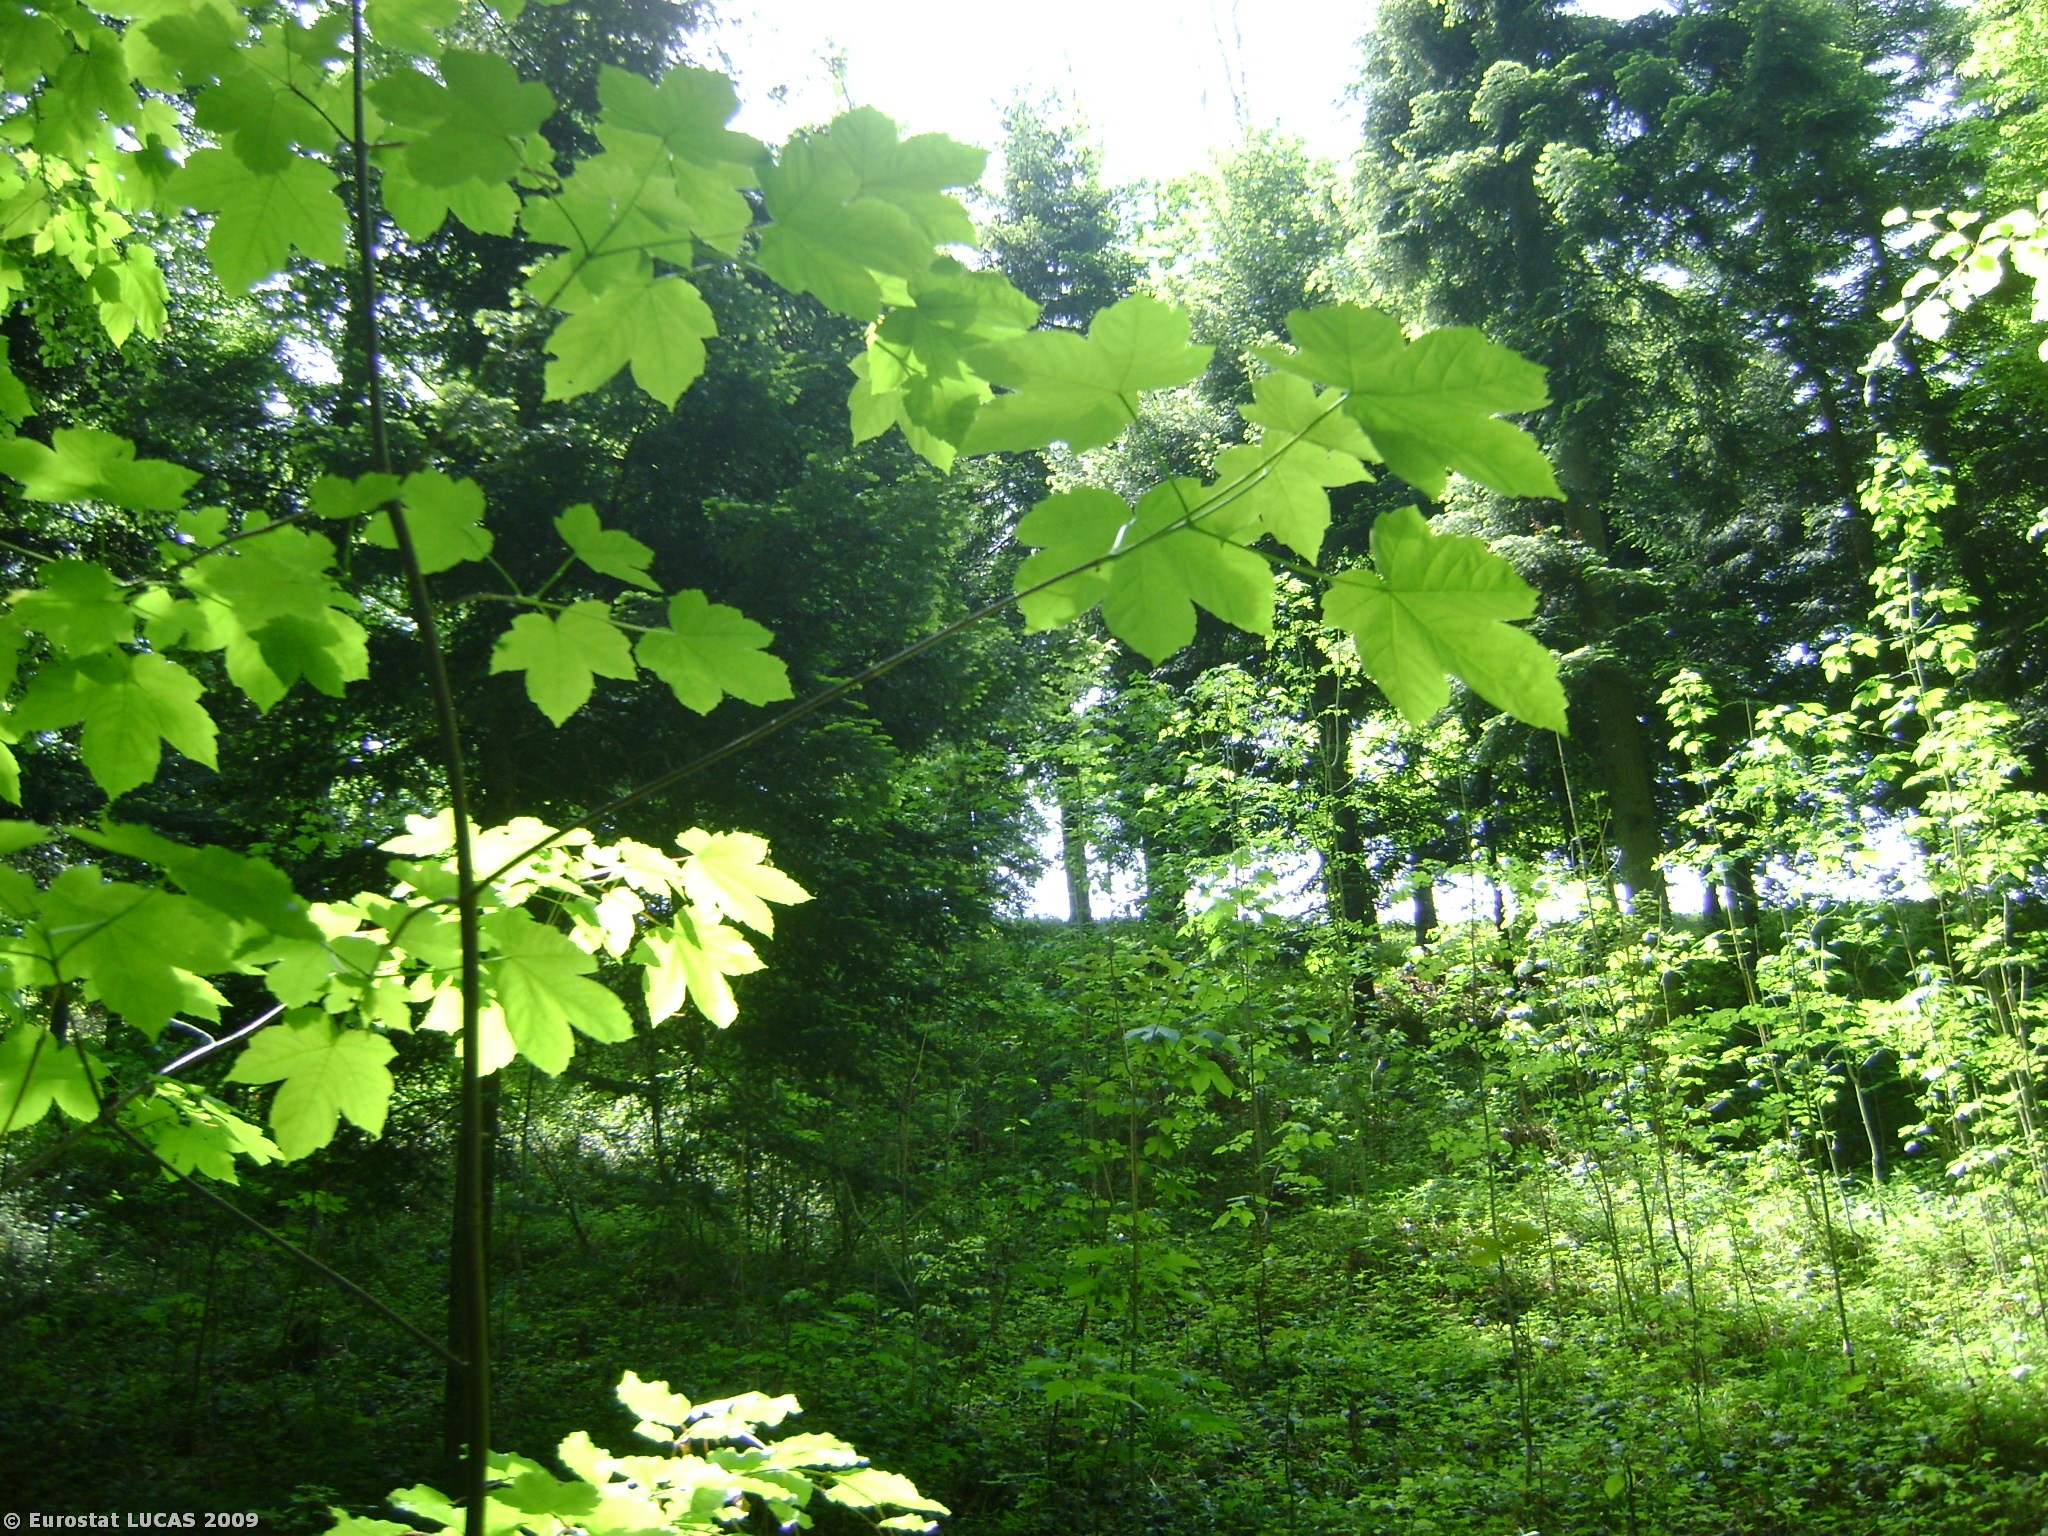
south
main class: Woodland
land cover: Mixed woodland
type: hemiboreal forest and nemoral coniferous forest and mixed broadleaved-coniferous forest
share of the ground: > 75 %
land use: Forestry
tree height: > 5 m
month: May
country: AT
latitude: 47.7175
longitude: 13.5045
